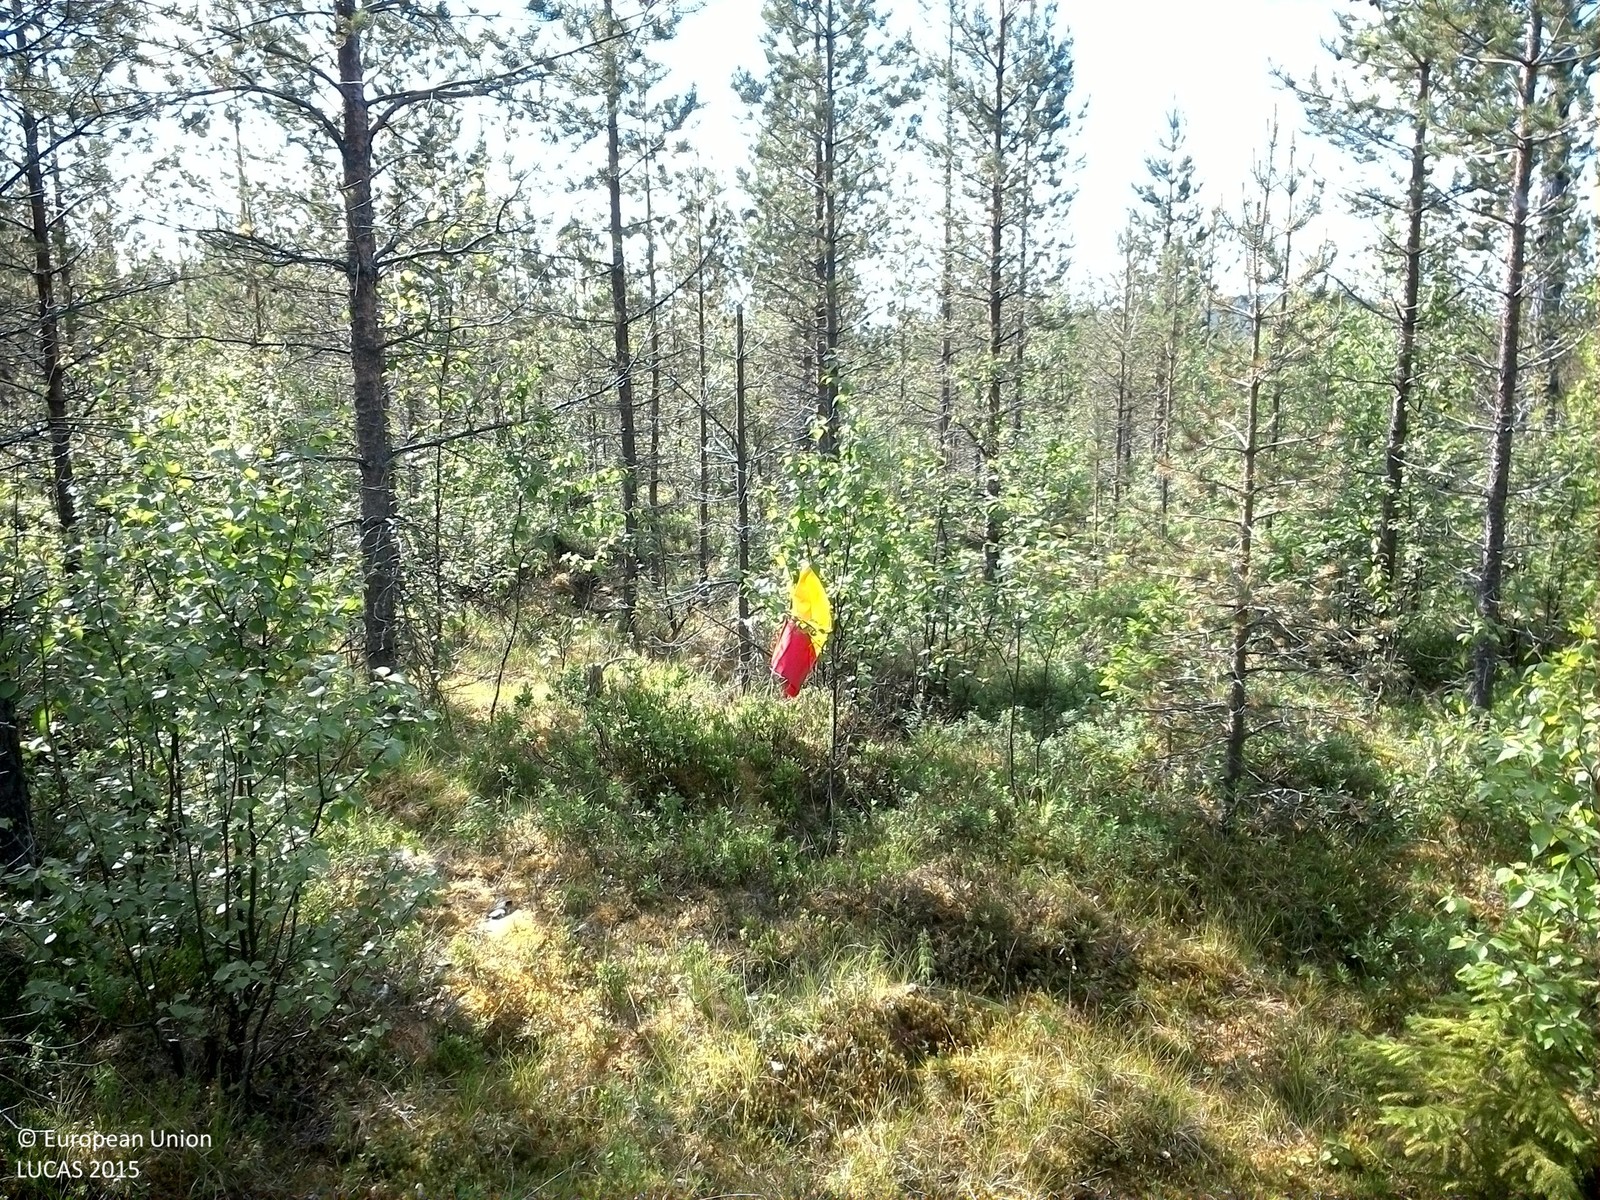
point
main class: Woodland
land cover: Pine dominated mixed woodland
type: boreal forest
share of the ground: 50 - 75 %
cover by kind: coniferous forest trees 40 %, shrubs 20 %, broadleaved forest trees 15 %, herbaceous plants 10 %, lichens and mosses 10 %, consolidated bare surface 5 %
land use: Forestry
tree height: < 5 m
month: July
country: SE
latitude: 64.3225
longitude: 16.8565
